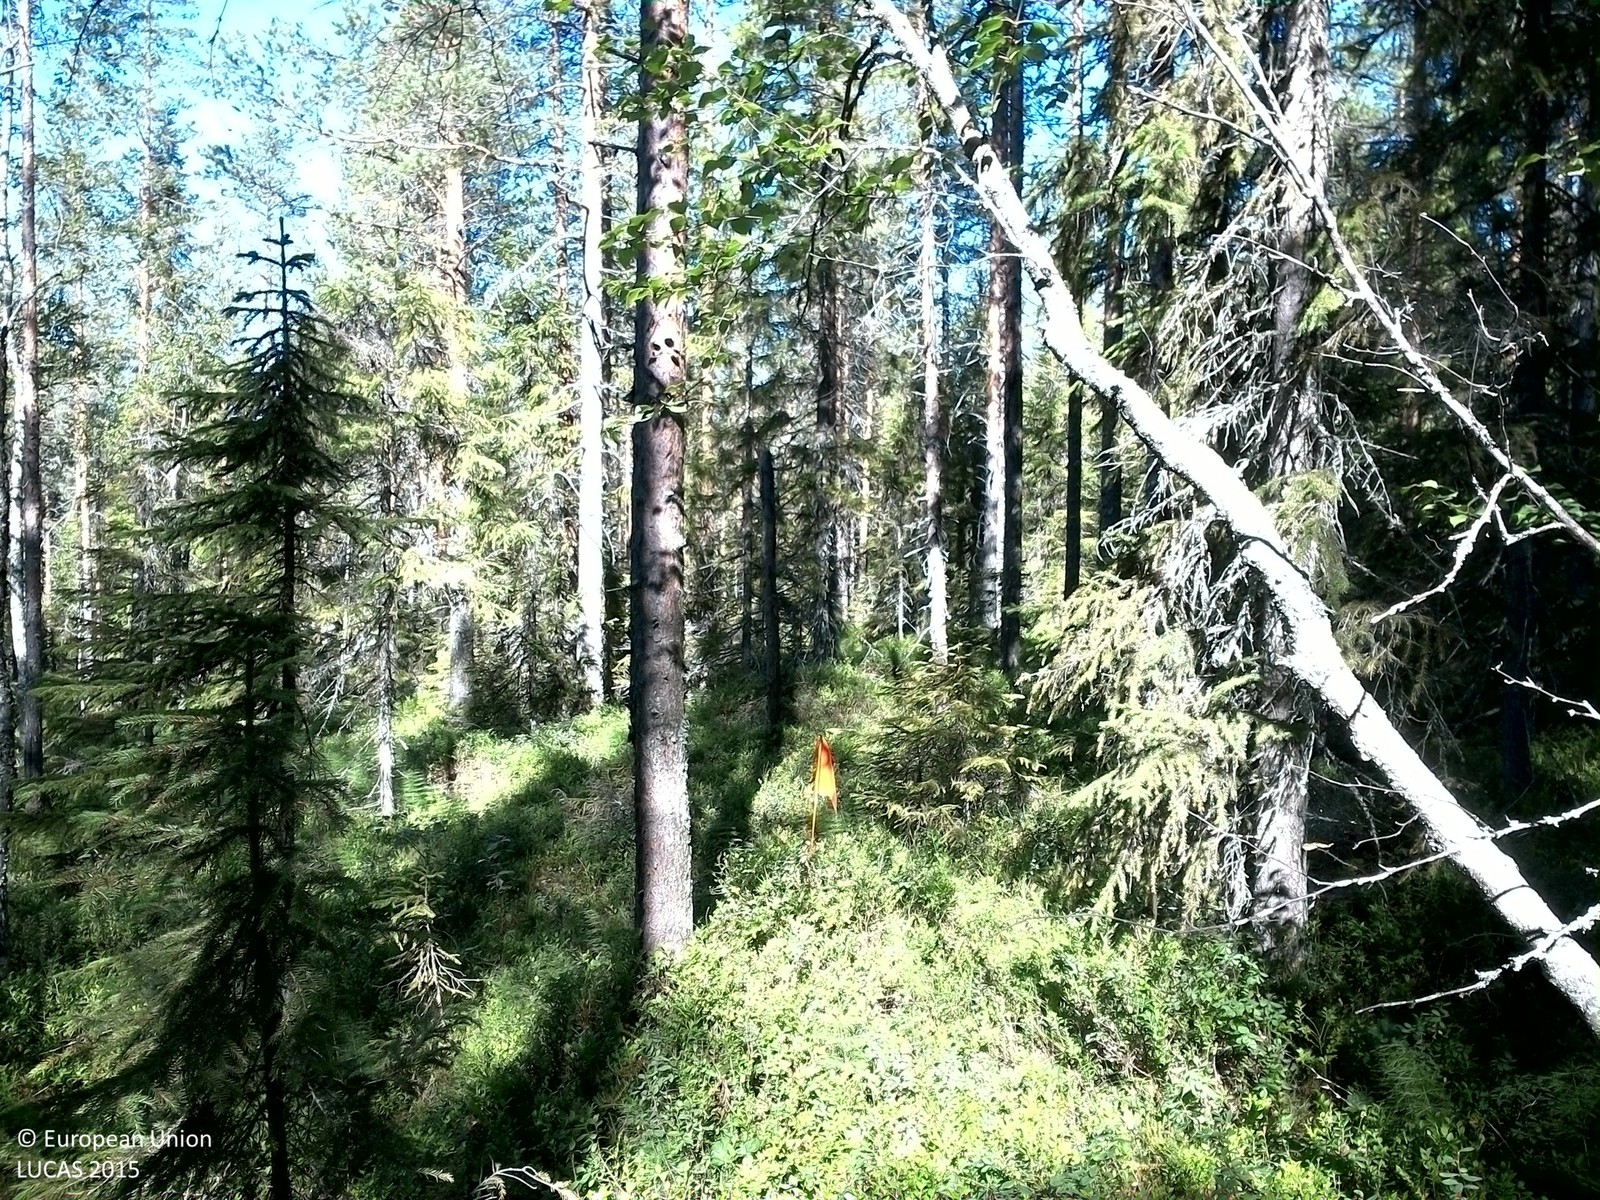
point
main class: Woodland
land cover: Pine dominated coniferous woodland
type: boreal forest
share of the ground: > 75 %
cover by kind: coniferous forest trees 65 %, shrubs 25 %, broadleaved forest trees 10 %
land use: Forestry
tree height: > 5 m
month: August
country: SE
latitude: 63.6739
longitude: 17.9162
